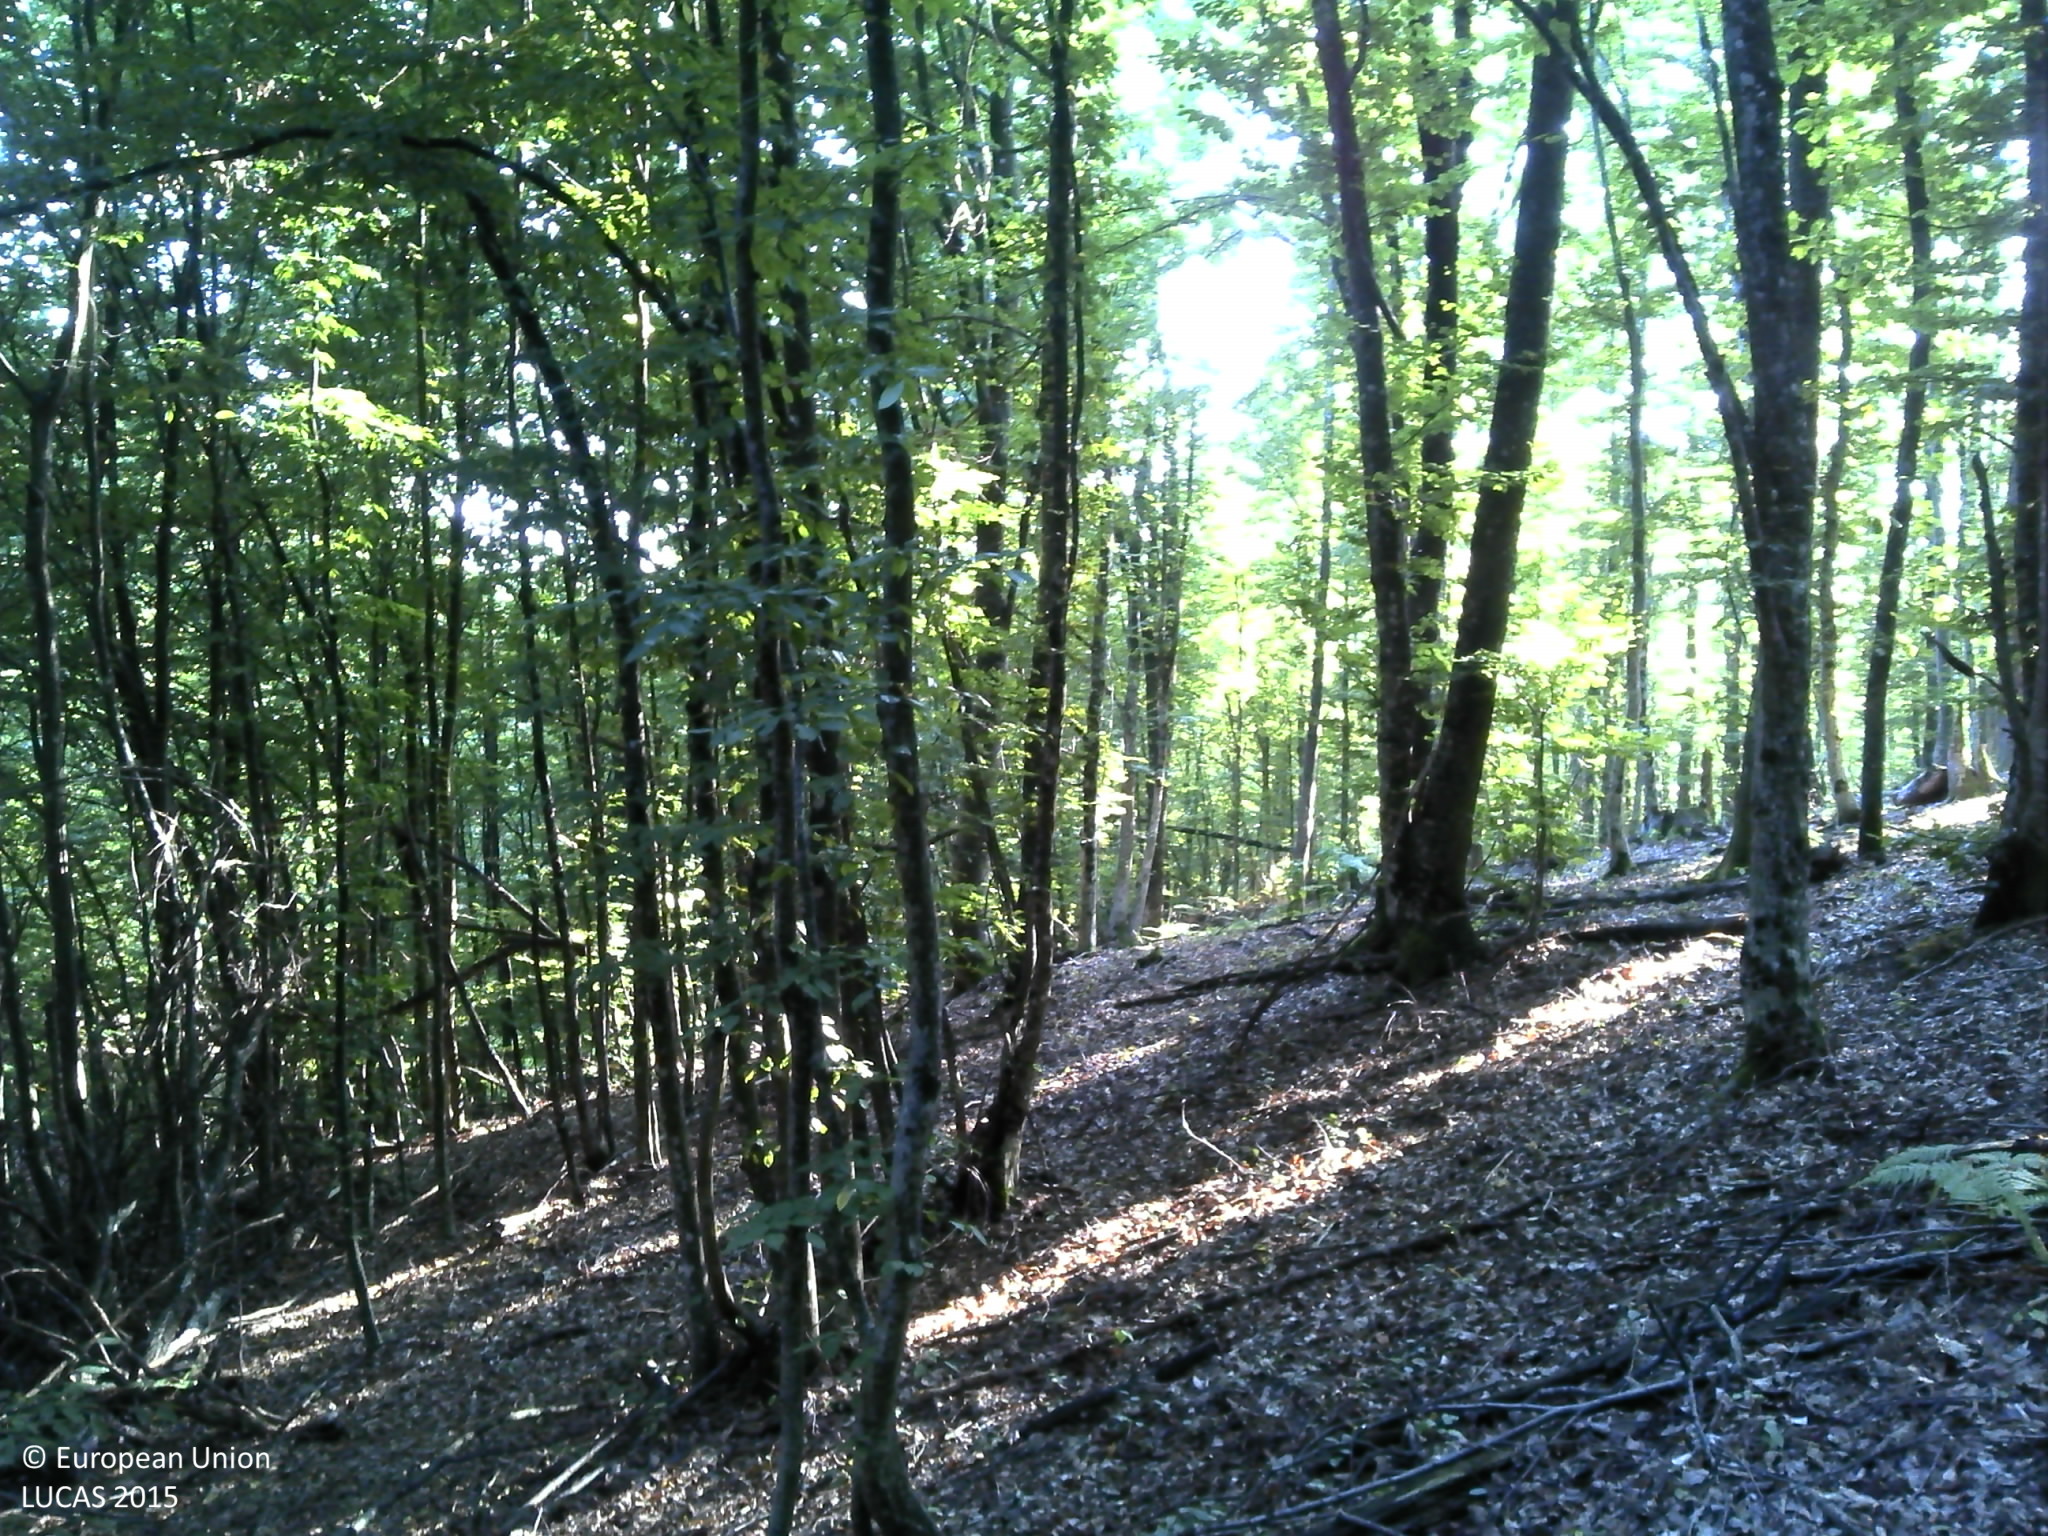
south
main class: Woodland
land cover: Broadleaved woodland
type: mesophytic deciduous forest
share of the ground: > 75 %
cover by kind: broadleaved forest trees 100 %
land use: Forestry
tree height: > 5 m
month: August
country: HR
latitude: 45.2384
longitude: 15.7665
